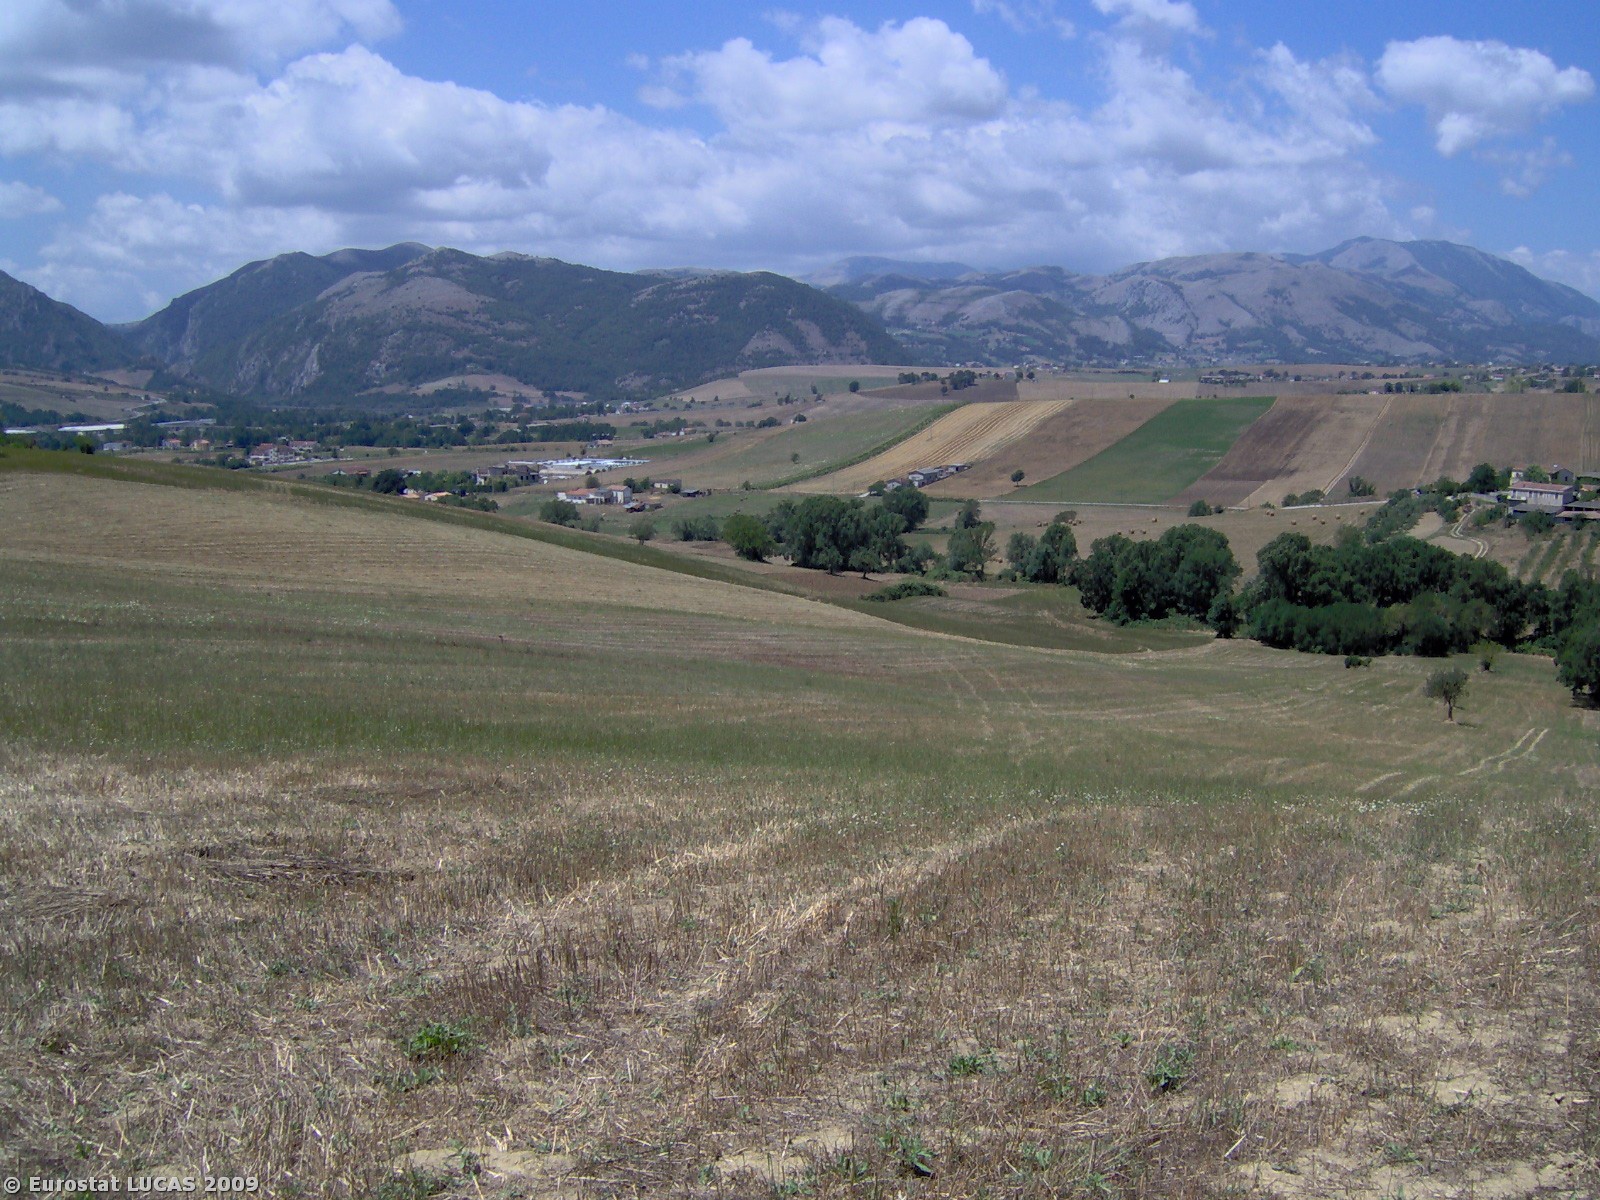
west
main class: Cropland
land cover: Temporary grasslands
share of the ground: 25 - 50 %
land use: Agriculture (excluding fallow land and kitchen gardens)
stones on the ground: < 10 %
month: July
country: IT
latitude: 40.7071
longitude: 15.5769
